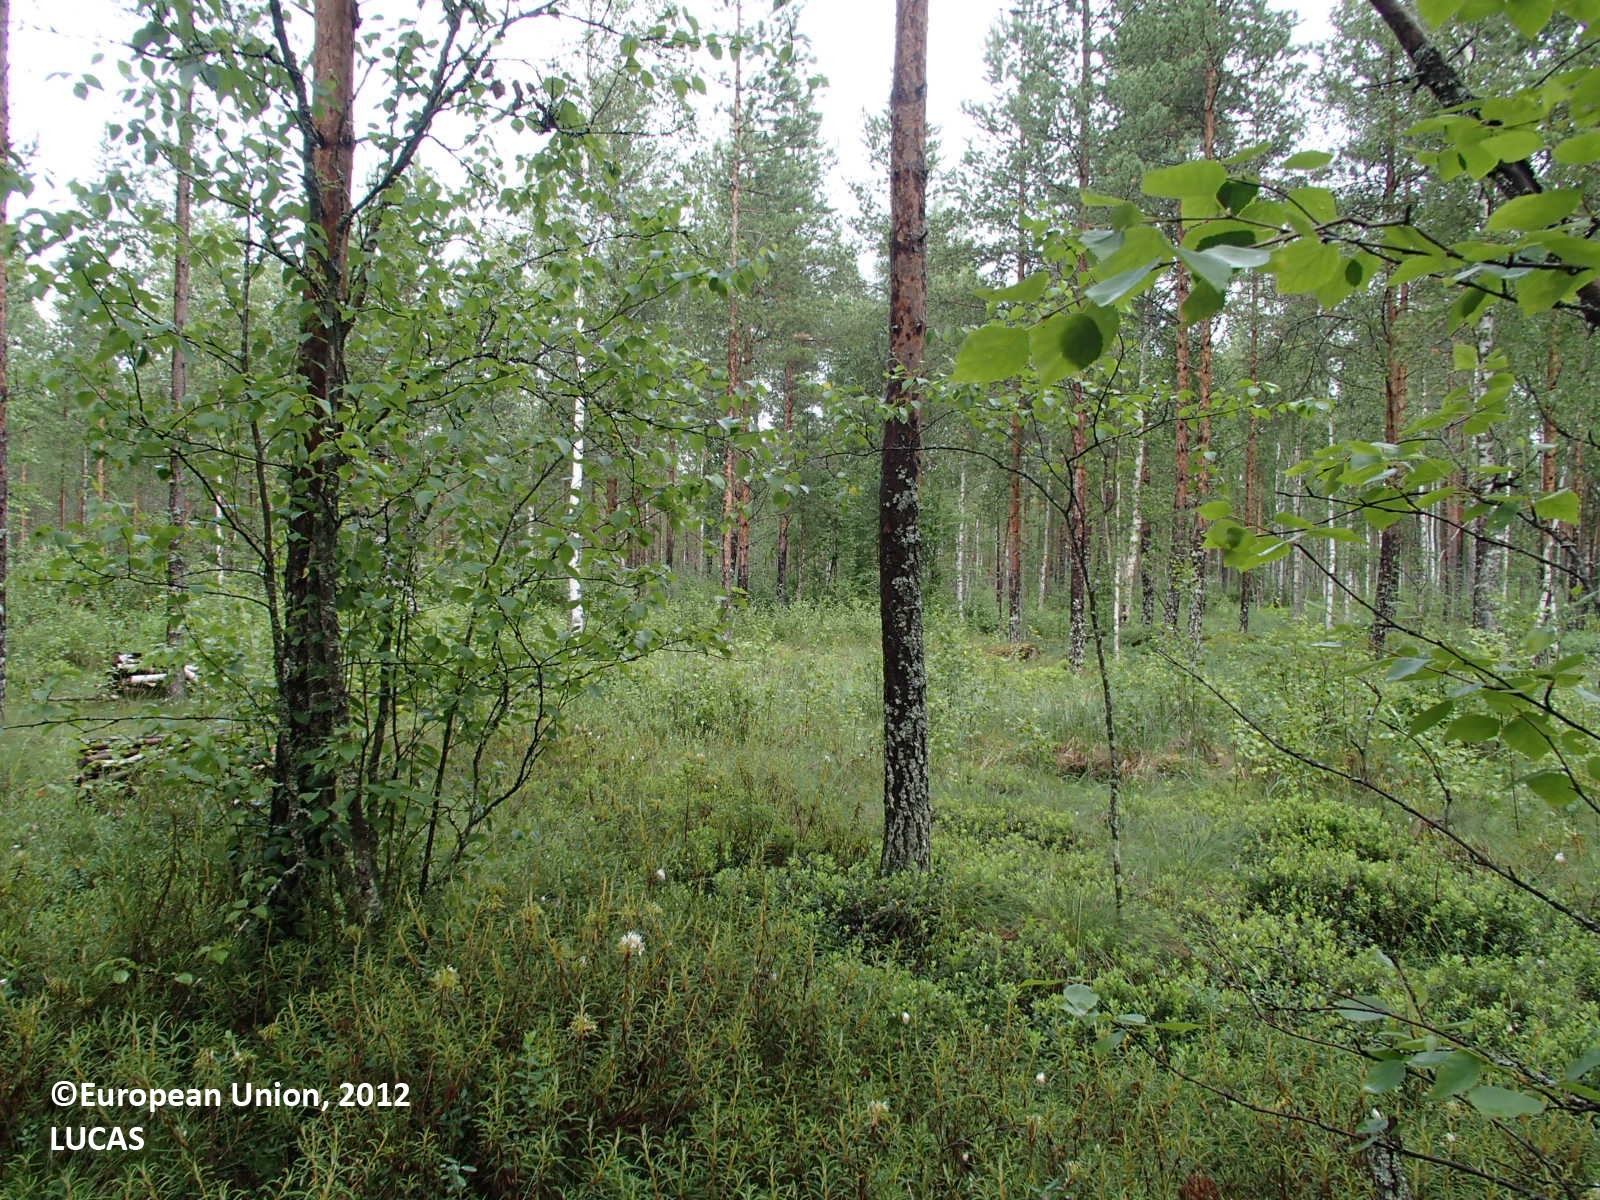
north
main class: Woodland
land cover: Pine dominated mixed woodland
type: boreal forest
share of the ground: > 75 %
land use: Forestry
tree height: > 5 m
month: July
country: FI
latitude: 64.3723
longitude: 26.3796
